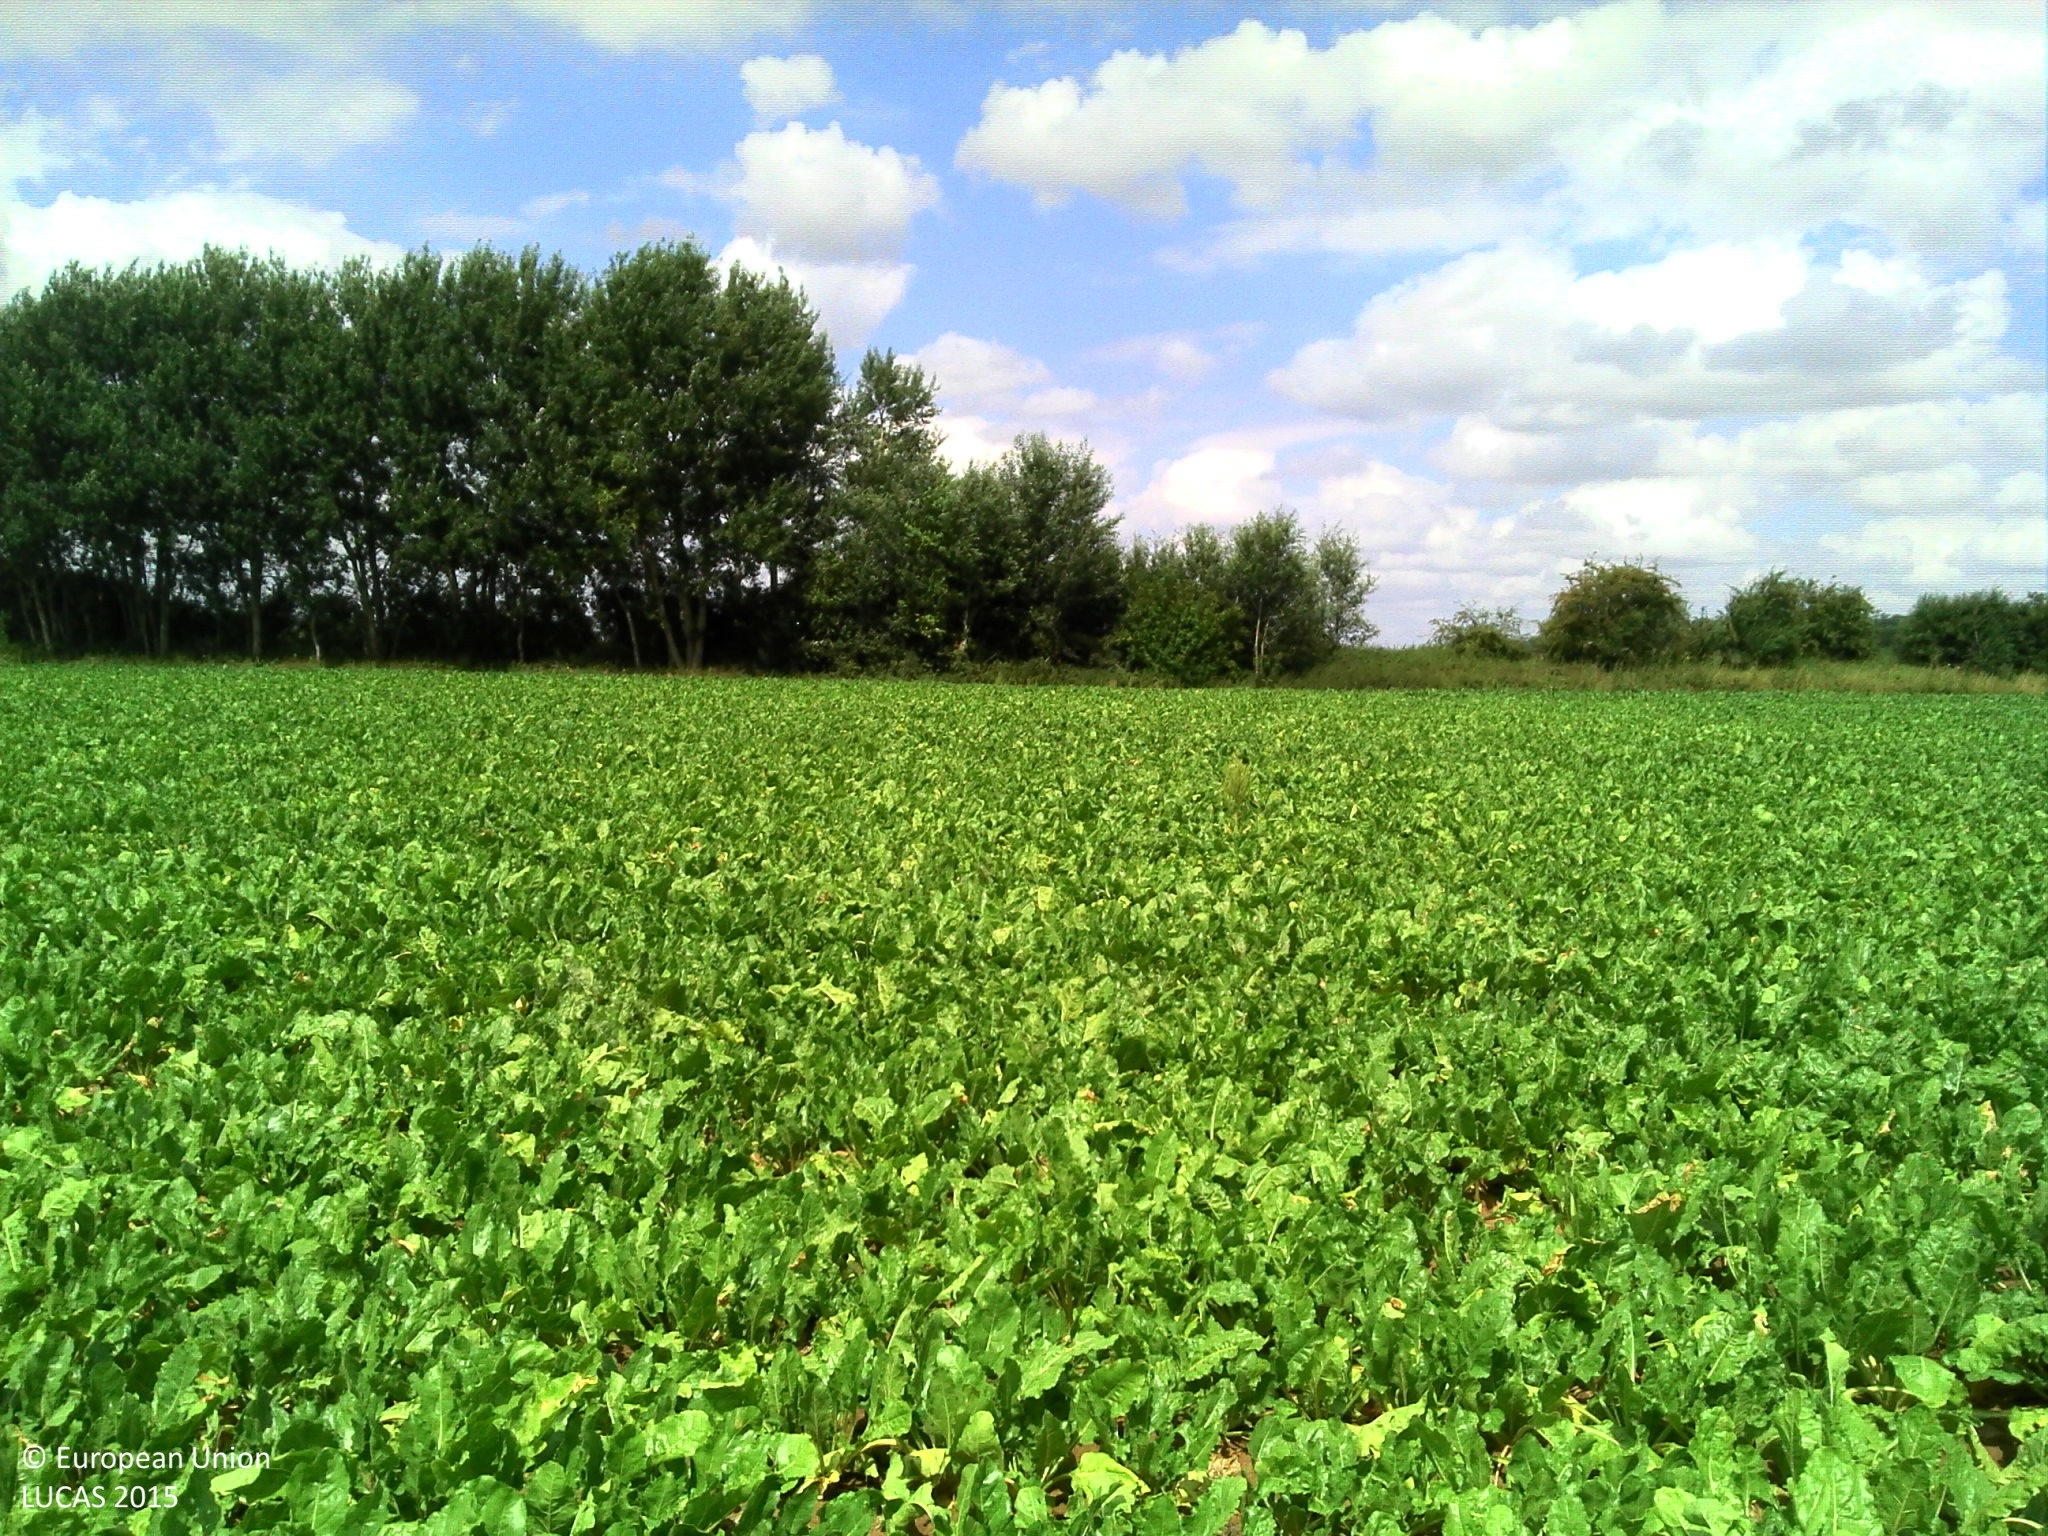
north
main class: Cropland
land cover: Sugar beet
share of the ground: > 75 %
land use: Agriculture (excluding fallow land and kitchen gardens)
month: August
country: FR
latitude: 49.8106
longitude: 2.7770
